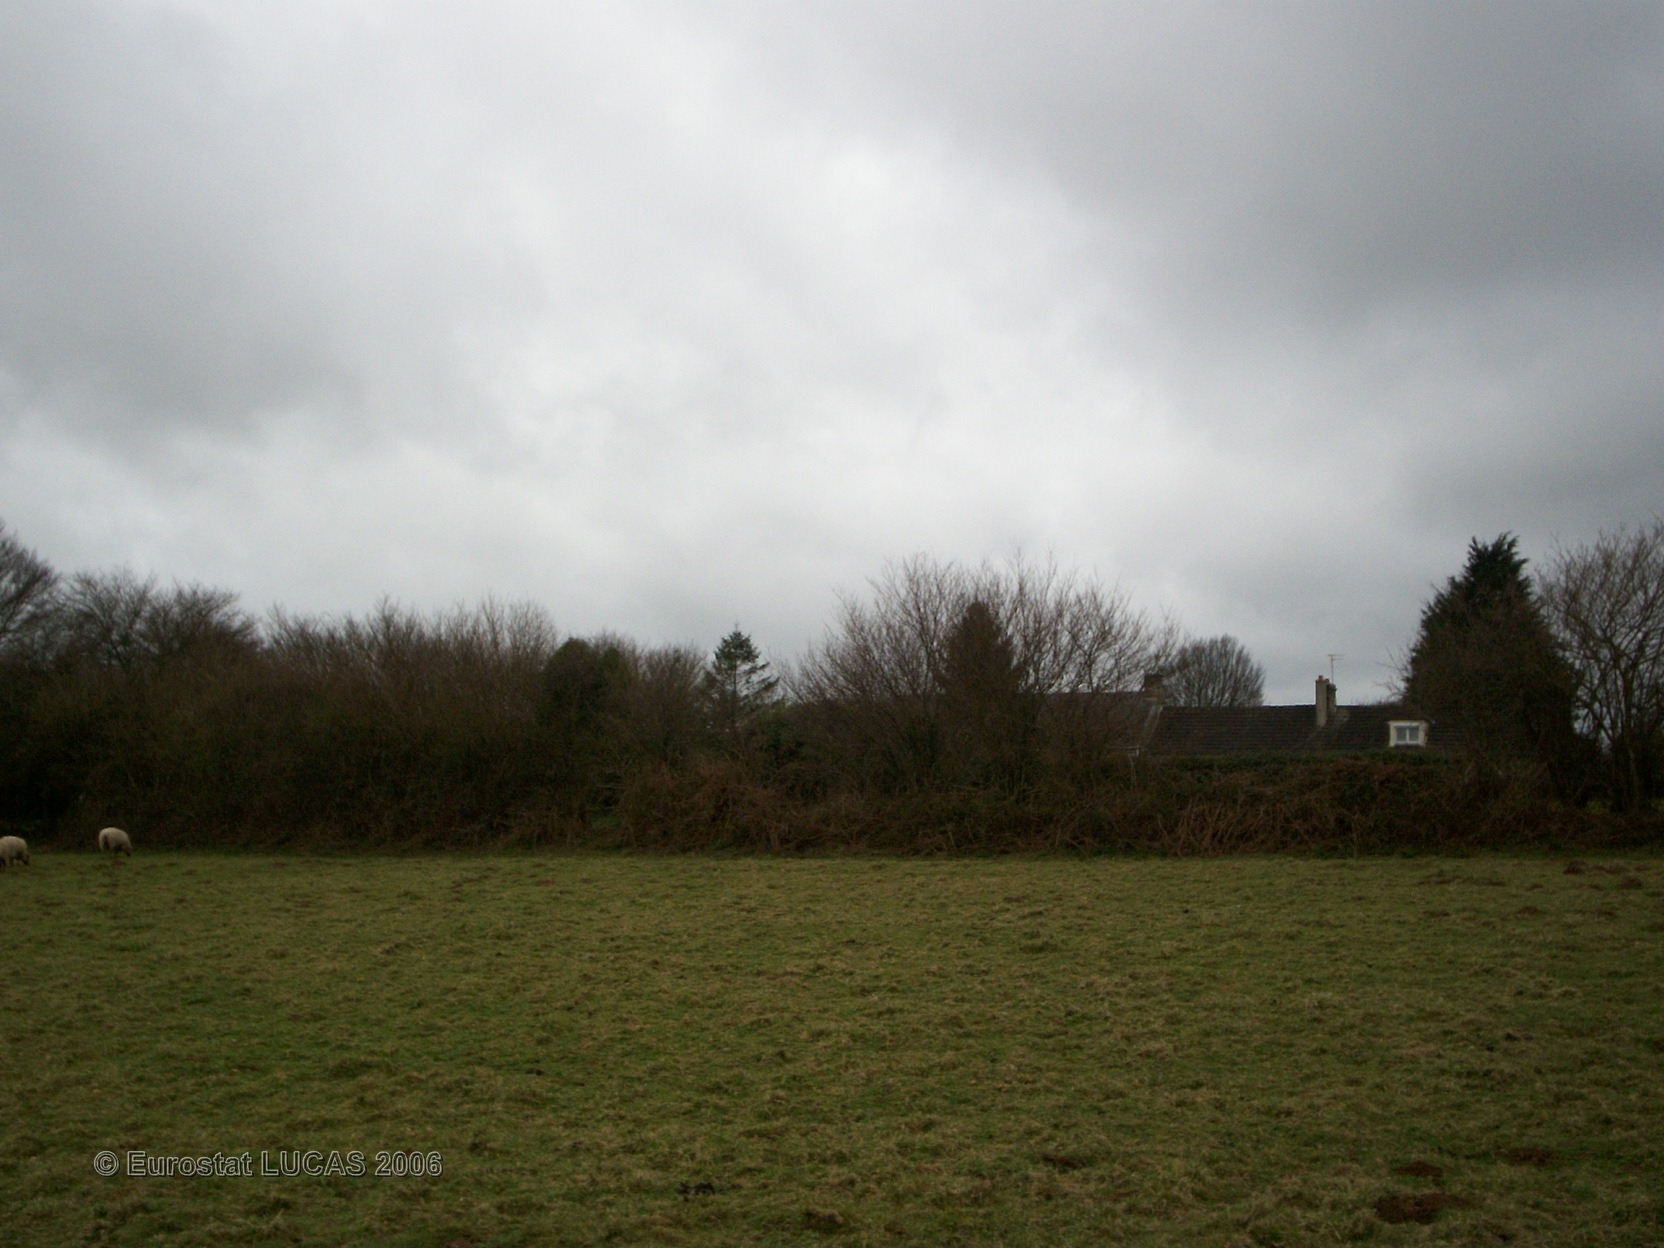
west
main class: Grassland
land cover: Grassland without tree/shrub cover
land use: Agriculture (excluding fallow land and kitchen gardens)
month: April
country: FR
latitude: 49.5719
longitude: -1.5975
